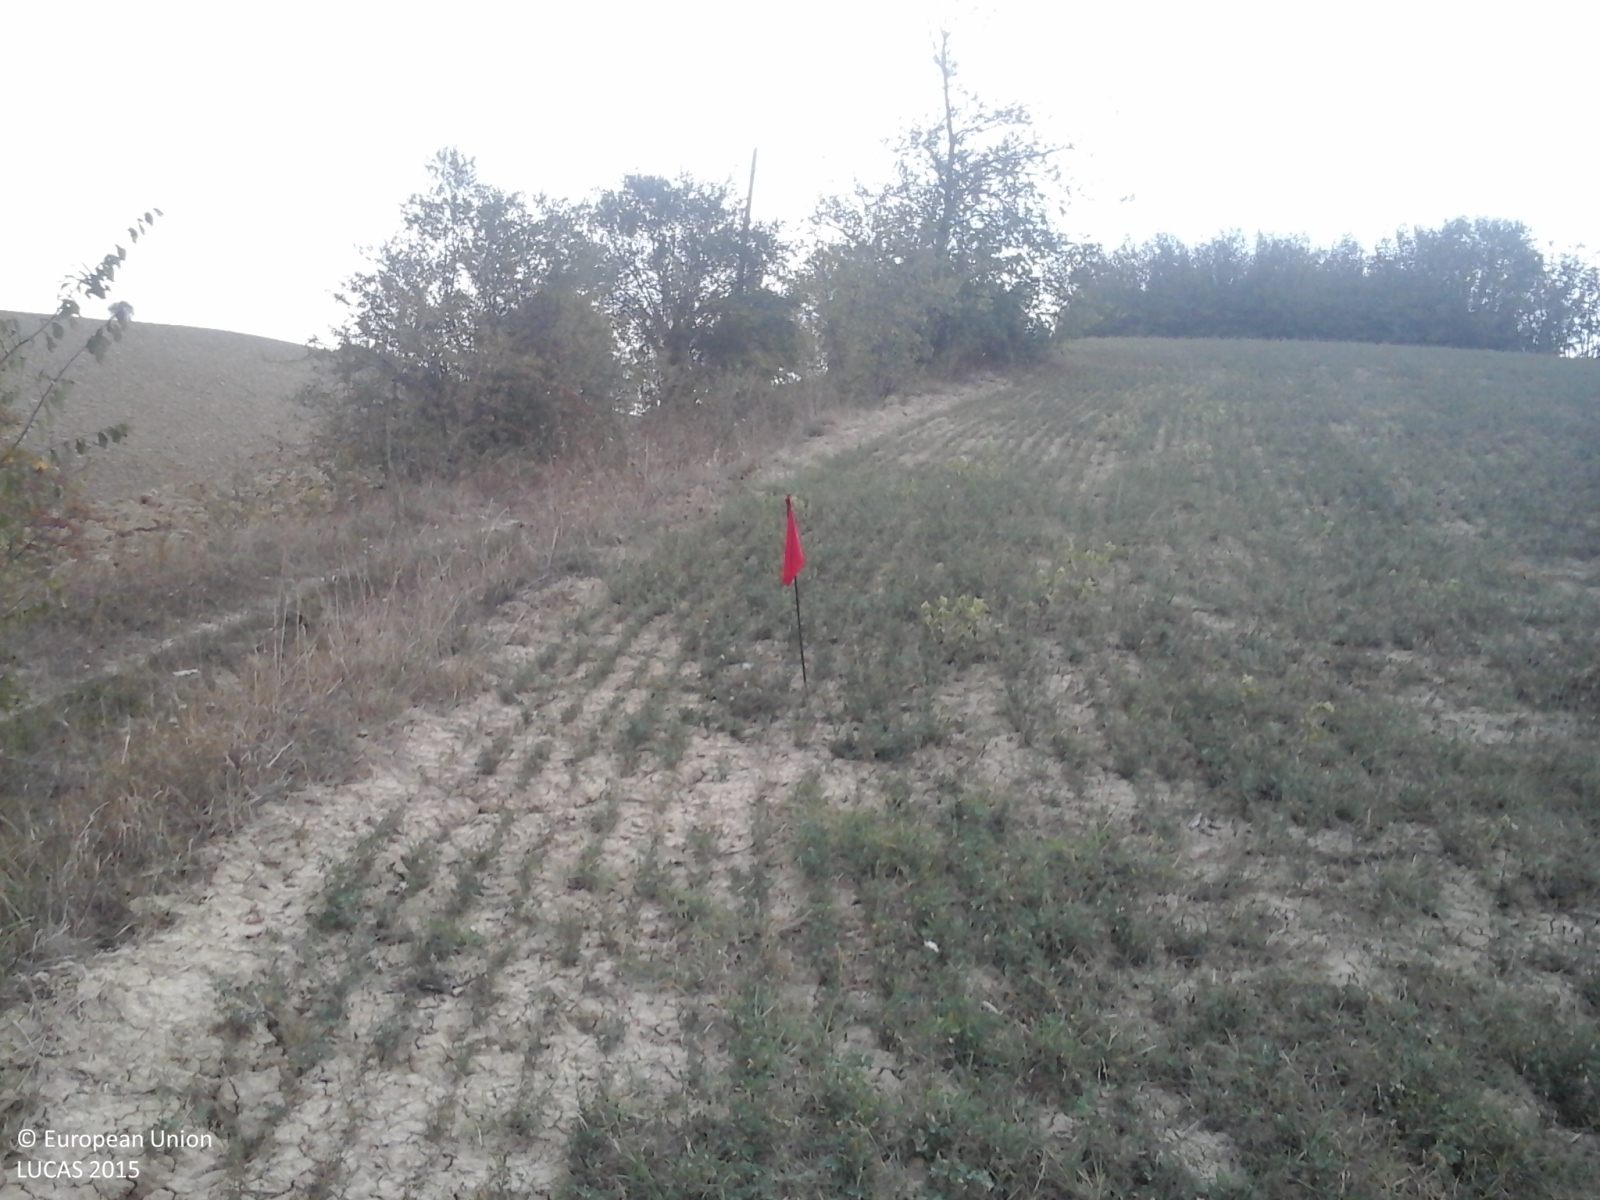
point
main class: Cropland
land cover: Lucerne
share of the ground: > 75 %
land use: Agriculture (excluding fallow land and kitchen gardens)
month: September
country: IT
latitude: 42.7972
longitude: 13.8650
